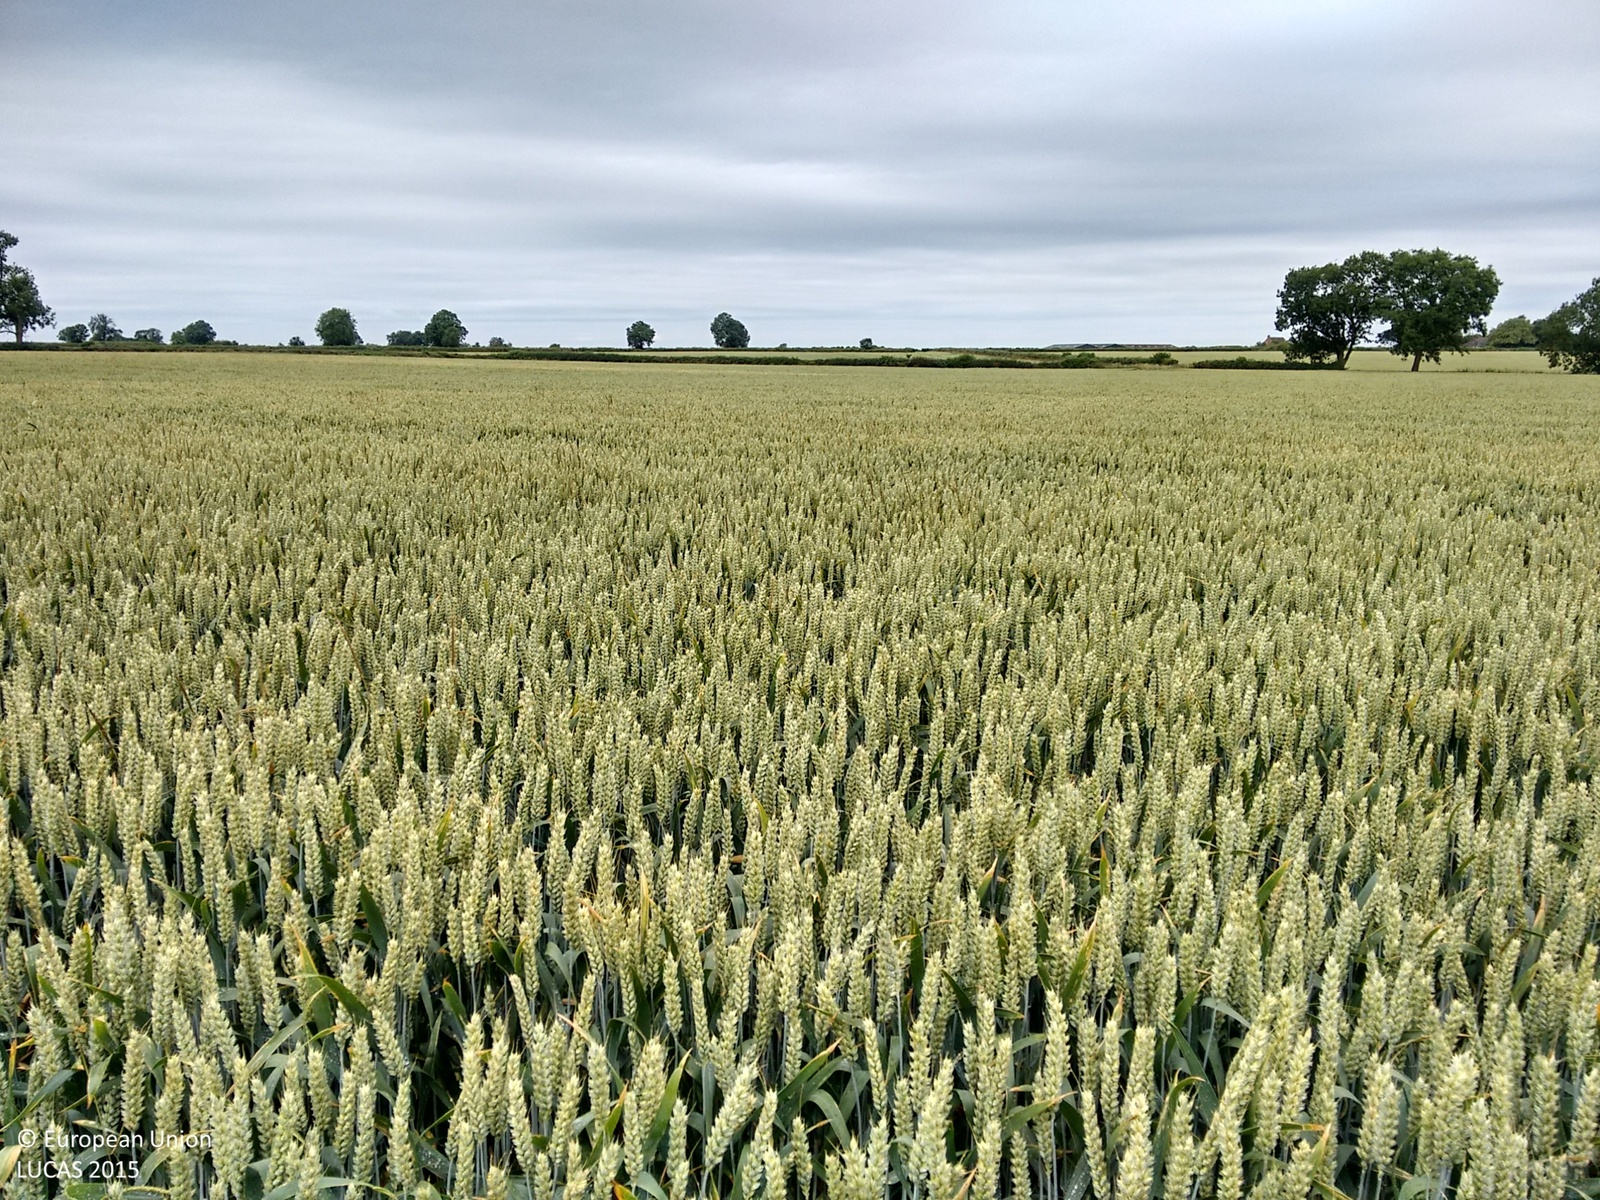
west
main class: Cropland
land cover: Common wheat
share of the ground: > 75 %
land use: Agriculture (excluding fallow land and kitchen gardens)
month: July
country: GB
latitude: 52.5302
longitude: -0.6682
